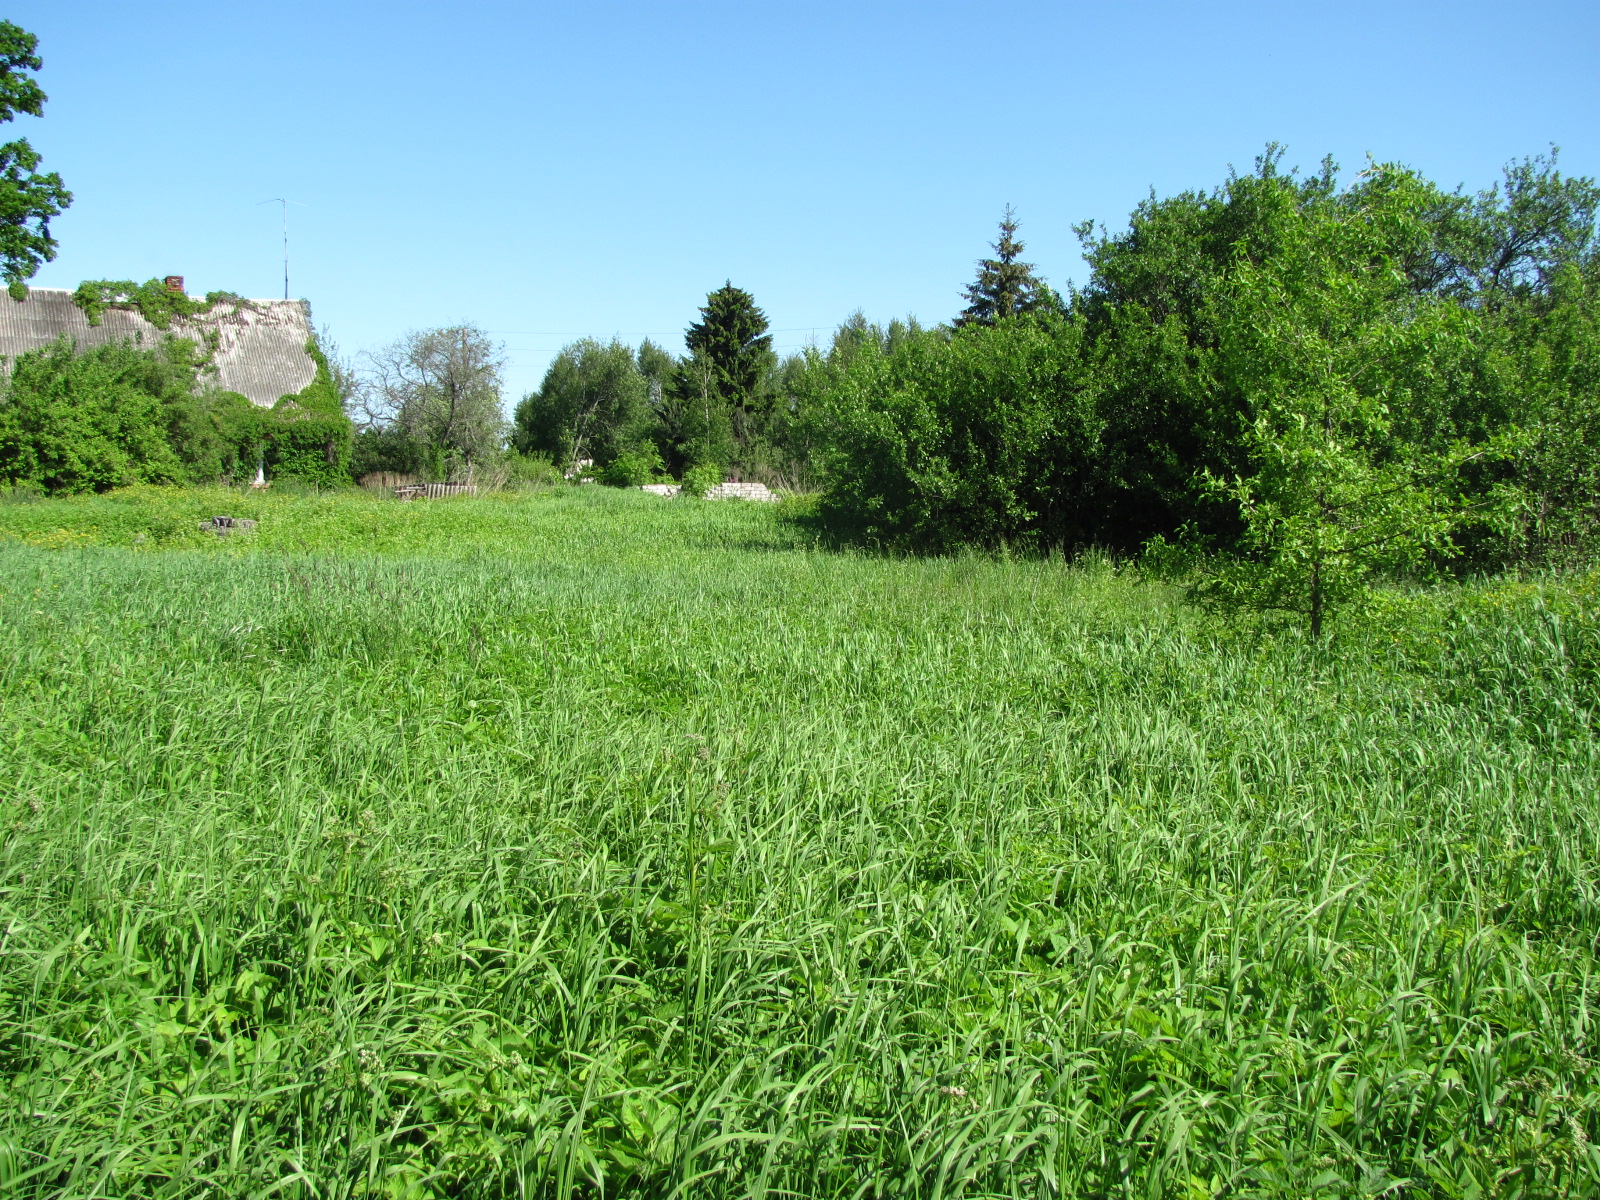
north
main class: Grassland
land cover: Grassland without tree/shrub cover
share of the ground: > 75 %
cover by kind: herbaceous plants 100 %
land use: Residential
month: June
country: LV
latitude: 56.5493
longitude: 24.3250
